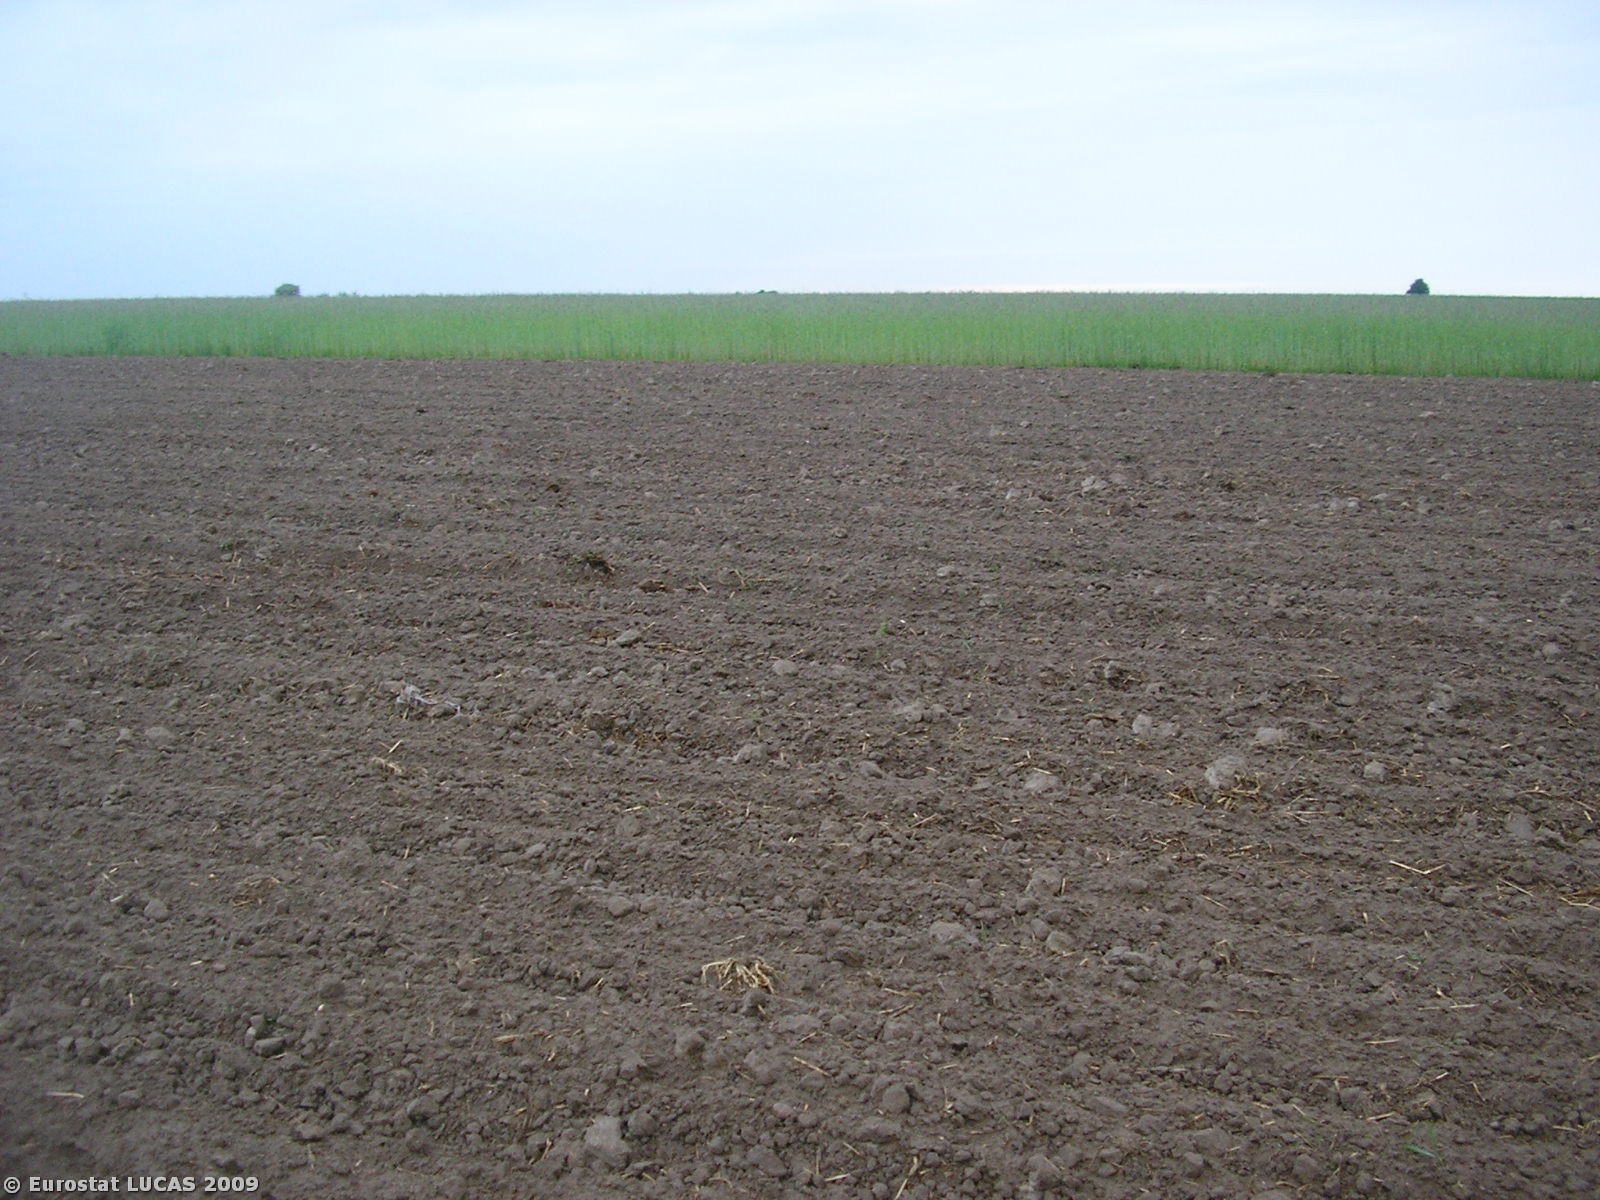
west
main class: Cropland
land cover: Triticale
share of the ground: > 75 %
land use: Agriculture (excluding fallow land and kitchen gardens)
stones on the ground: < 10 %
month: May
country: PL
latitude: 51.8248
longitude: 20.0299
